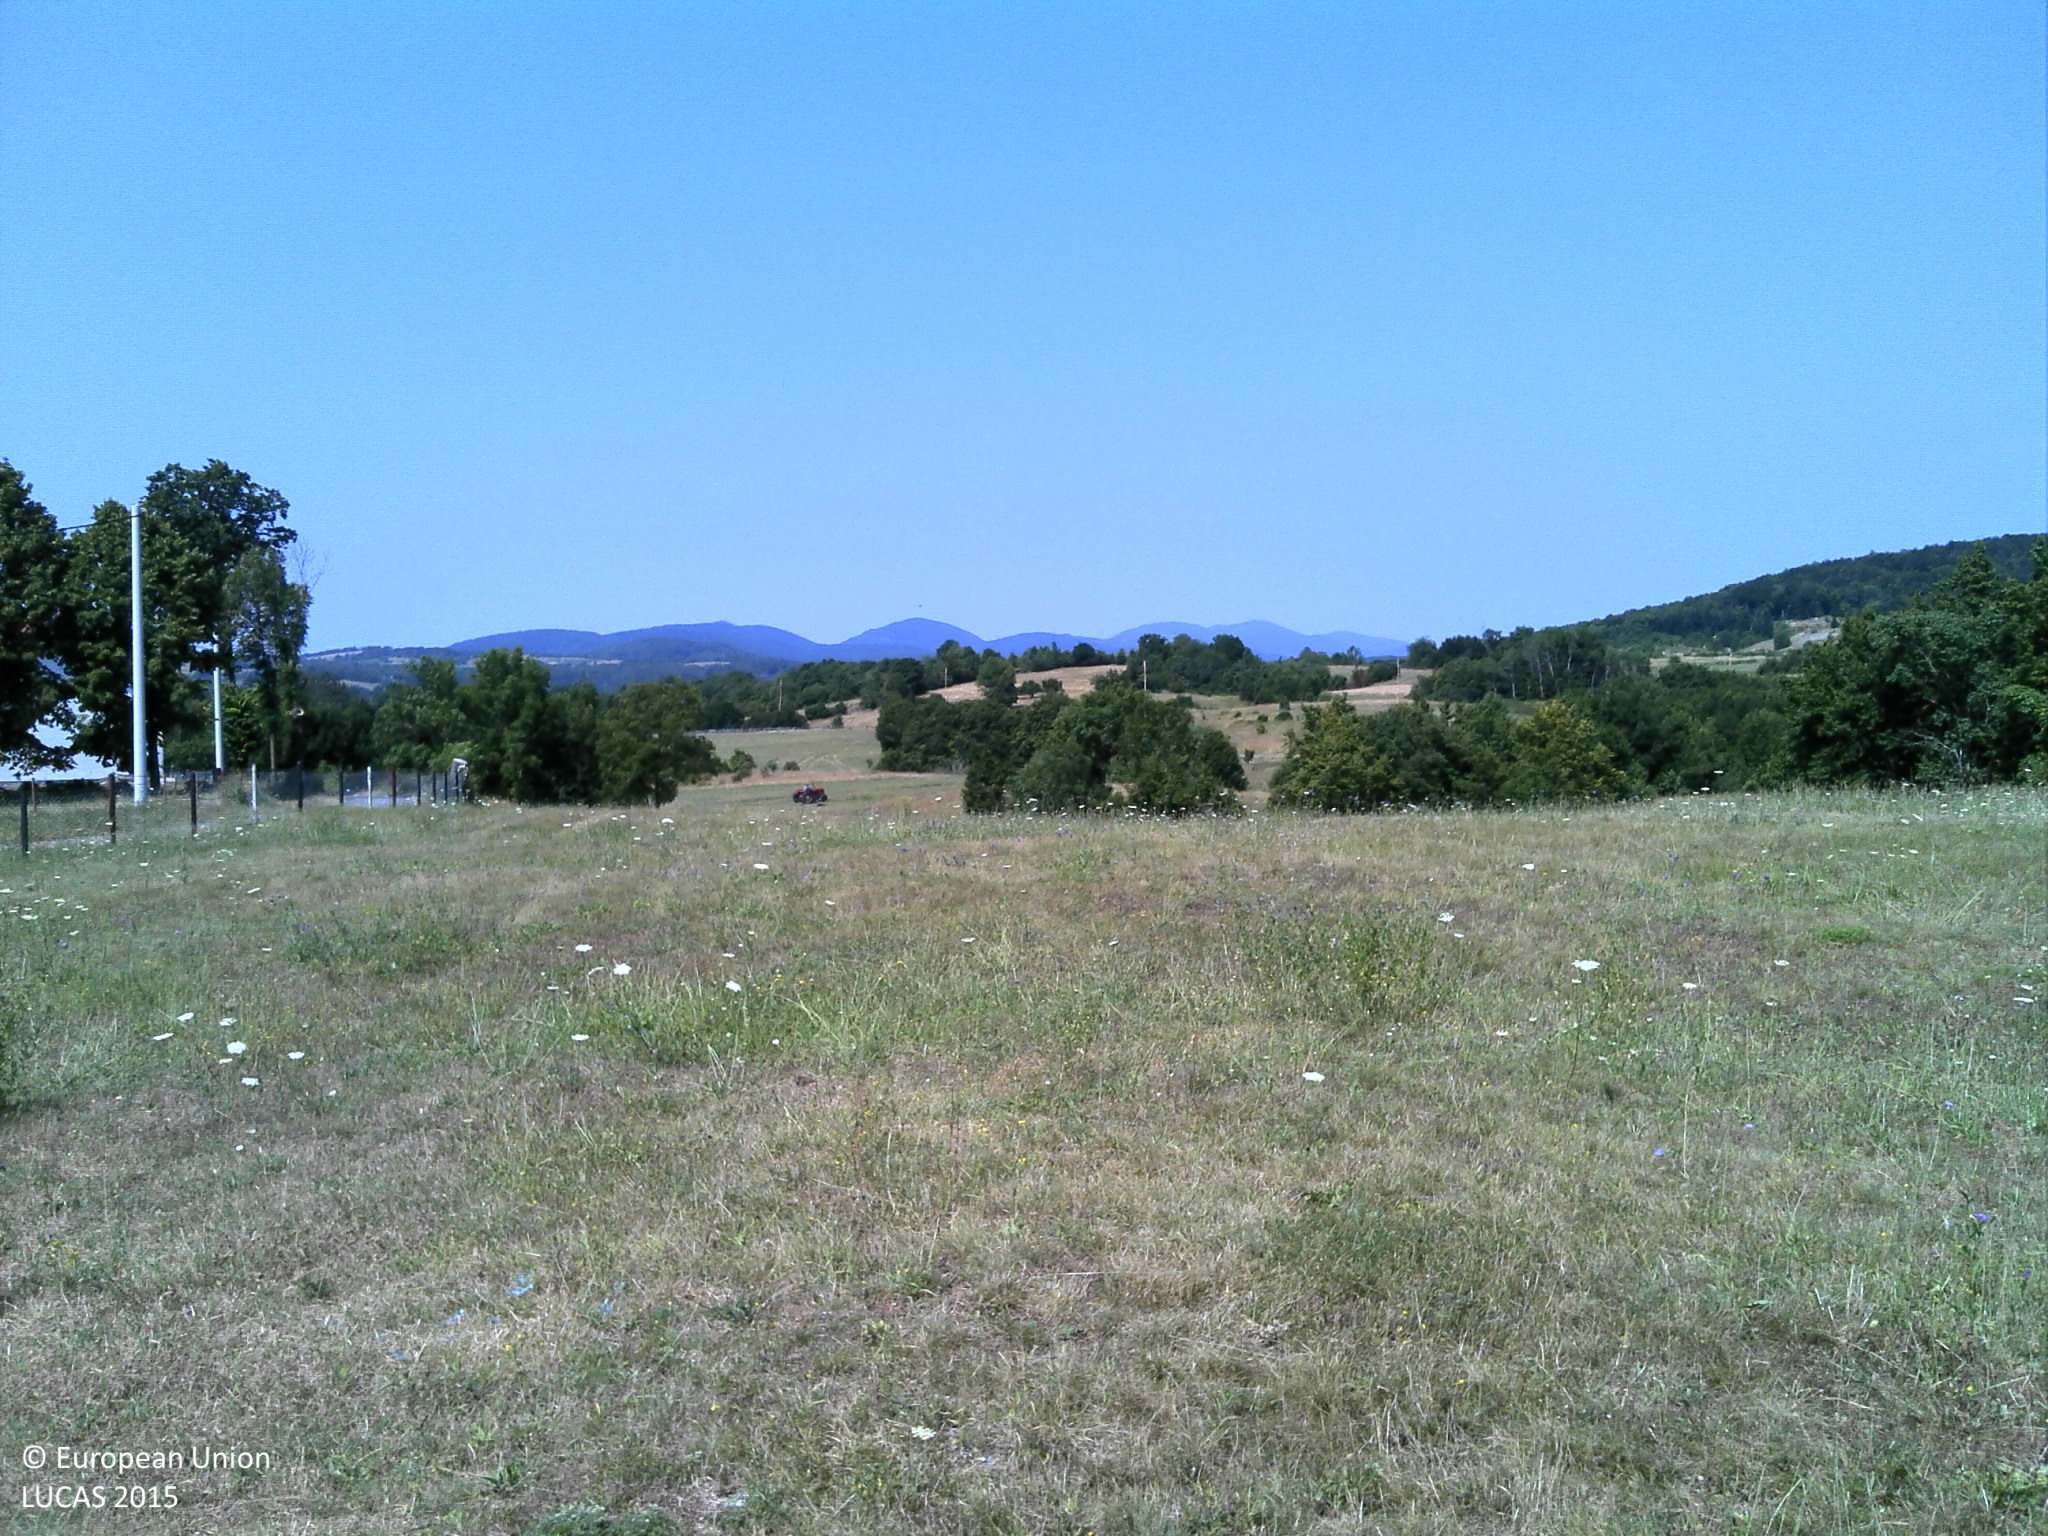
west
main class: Grassland
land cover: Grassland without tree/shrub cover
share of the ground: > 75 %
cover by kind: herbaceous plants 100 %
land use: Agriculture (excluding fallow land and kitchen gardens)
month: July
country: HR
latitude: 45.0339
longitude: 15.1862
